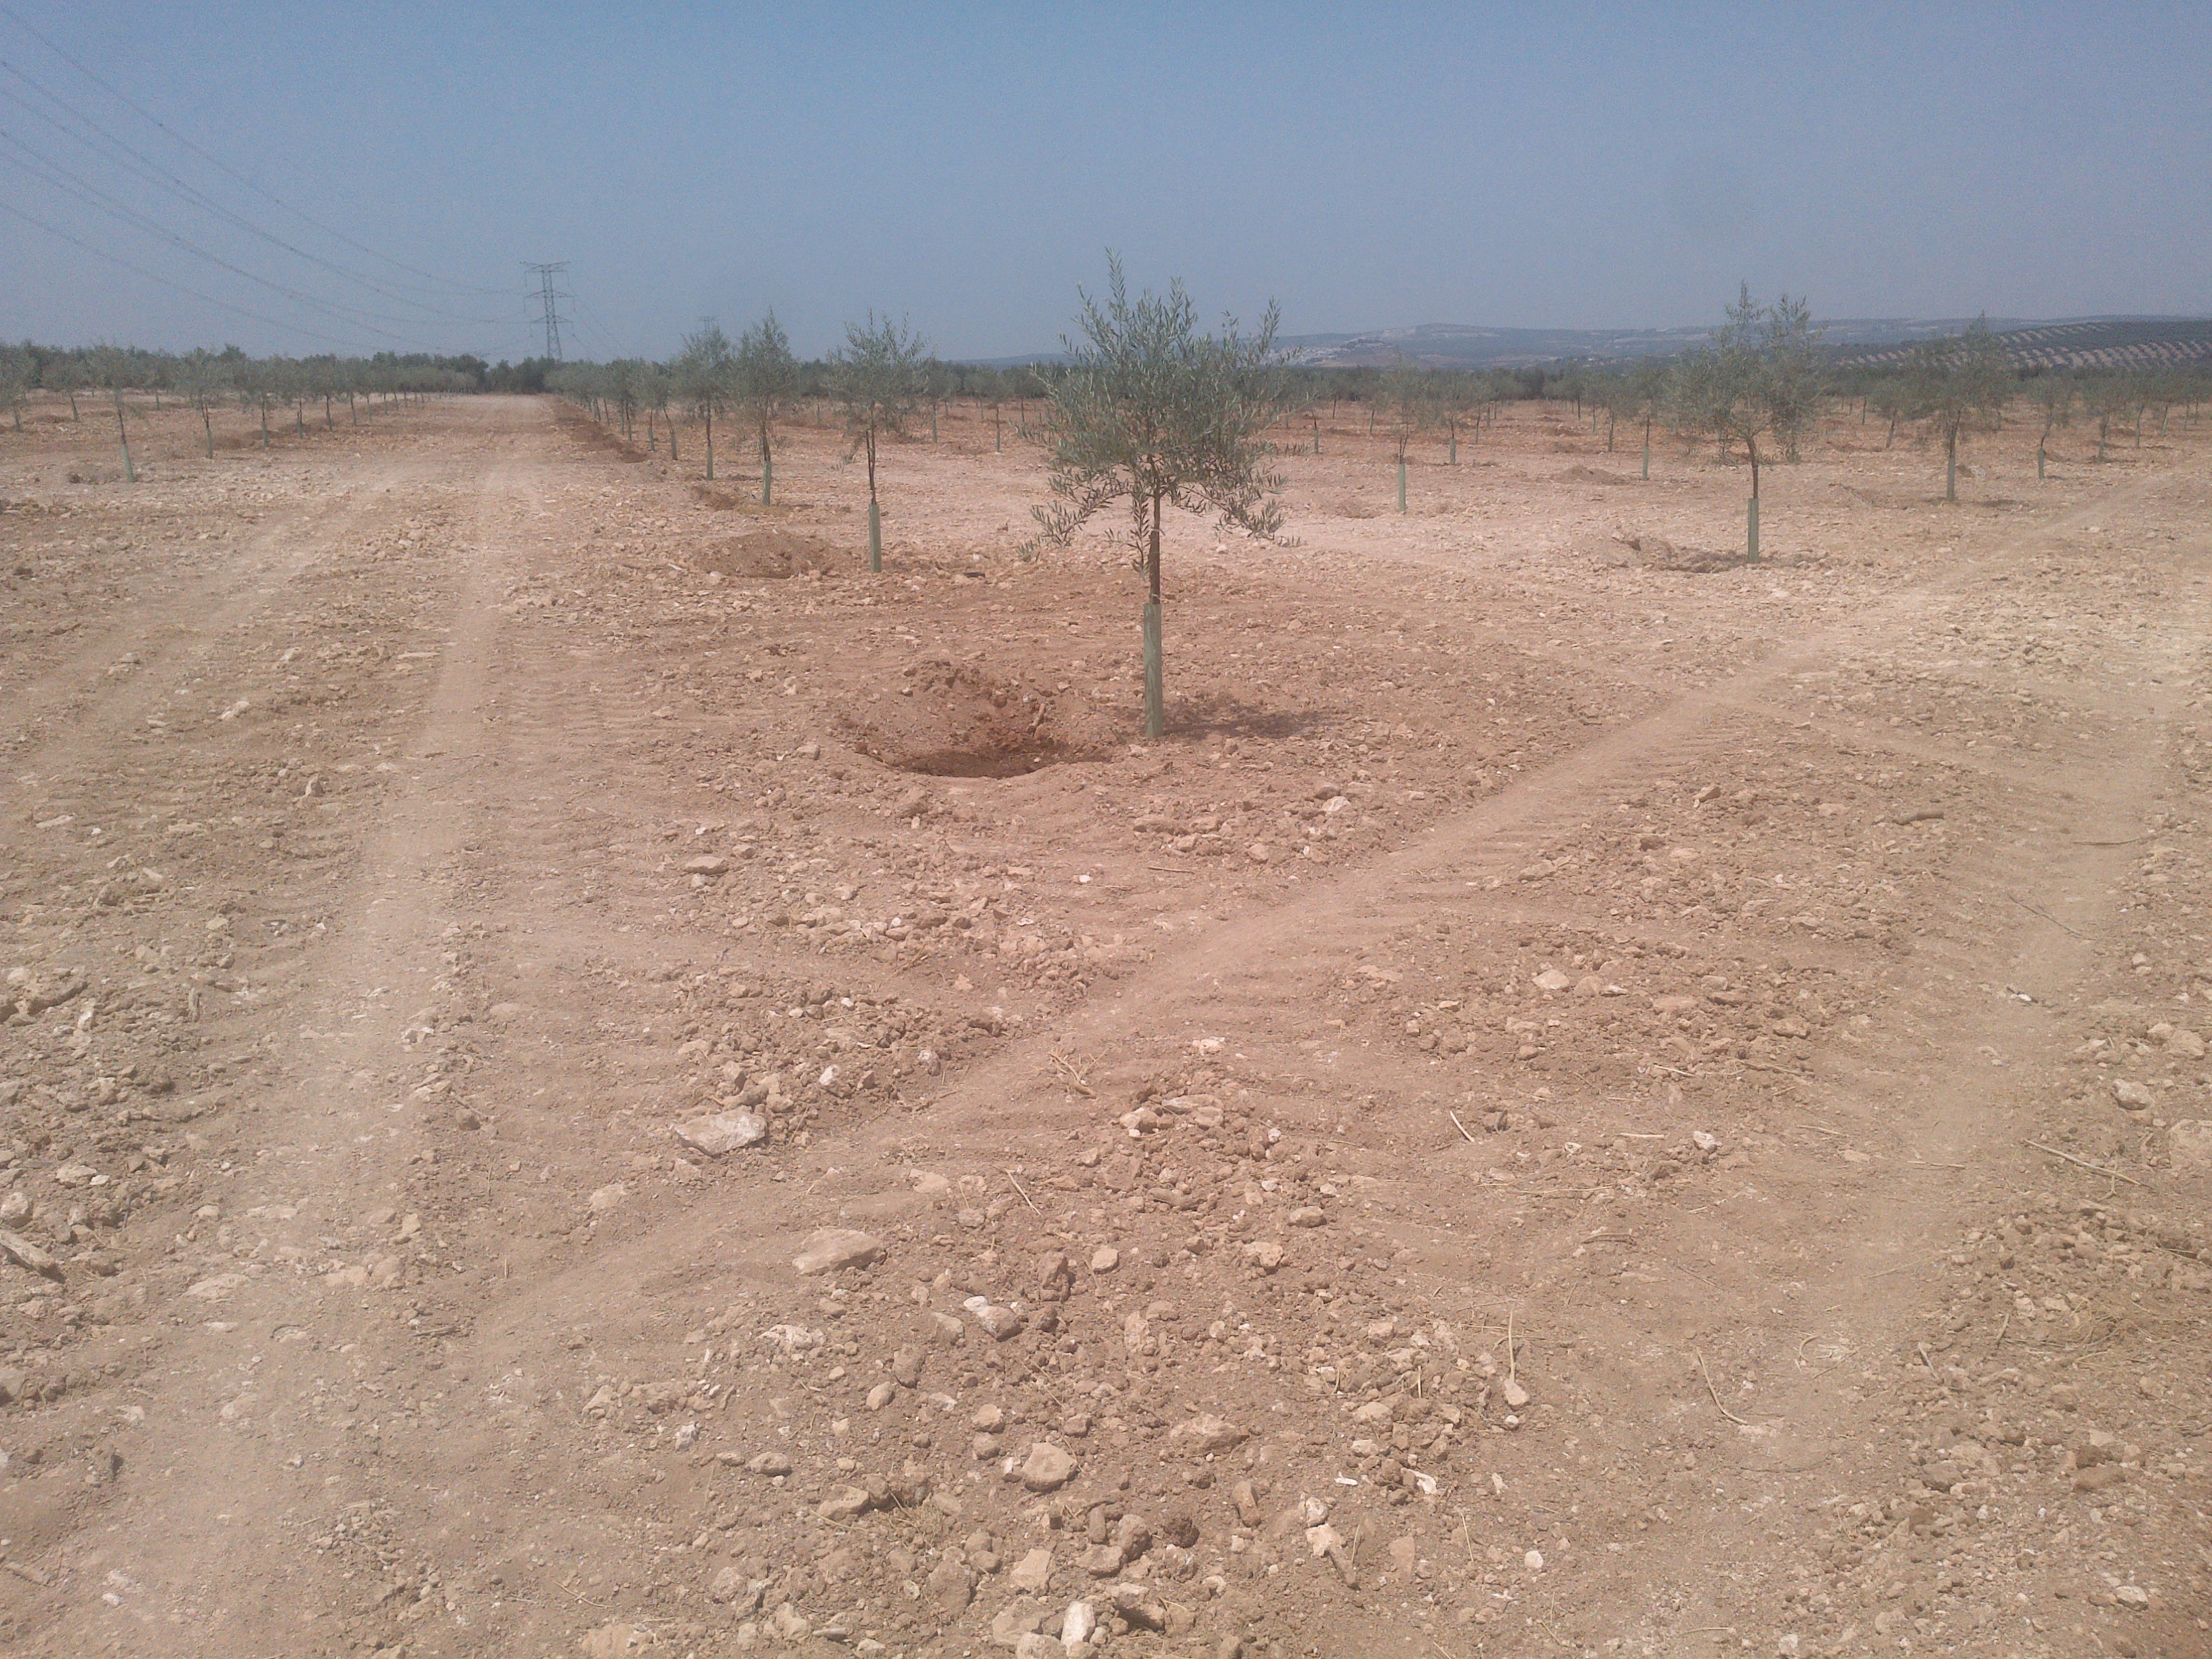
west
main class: Cropland
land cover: Olive groves
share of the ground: < 10 %
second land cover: Other bare soil
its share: > 75 %
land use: Agriculture (excluding fallow land and kitchen gardens)
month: July
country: ES
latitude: 37.4560
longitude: -4.5079
